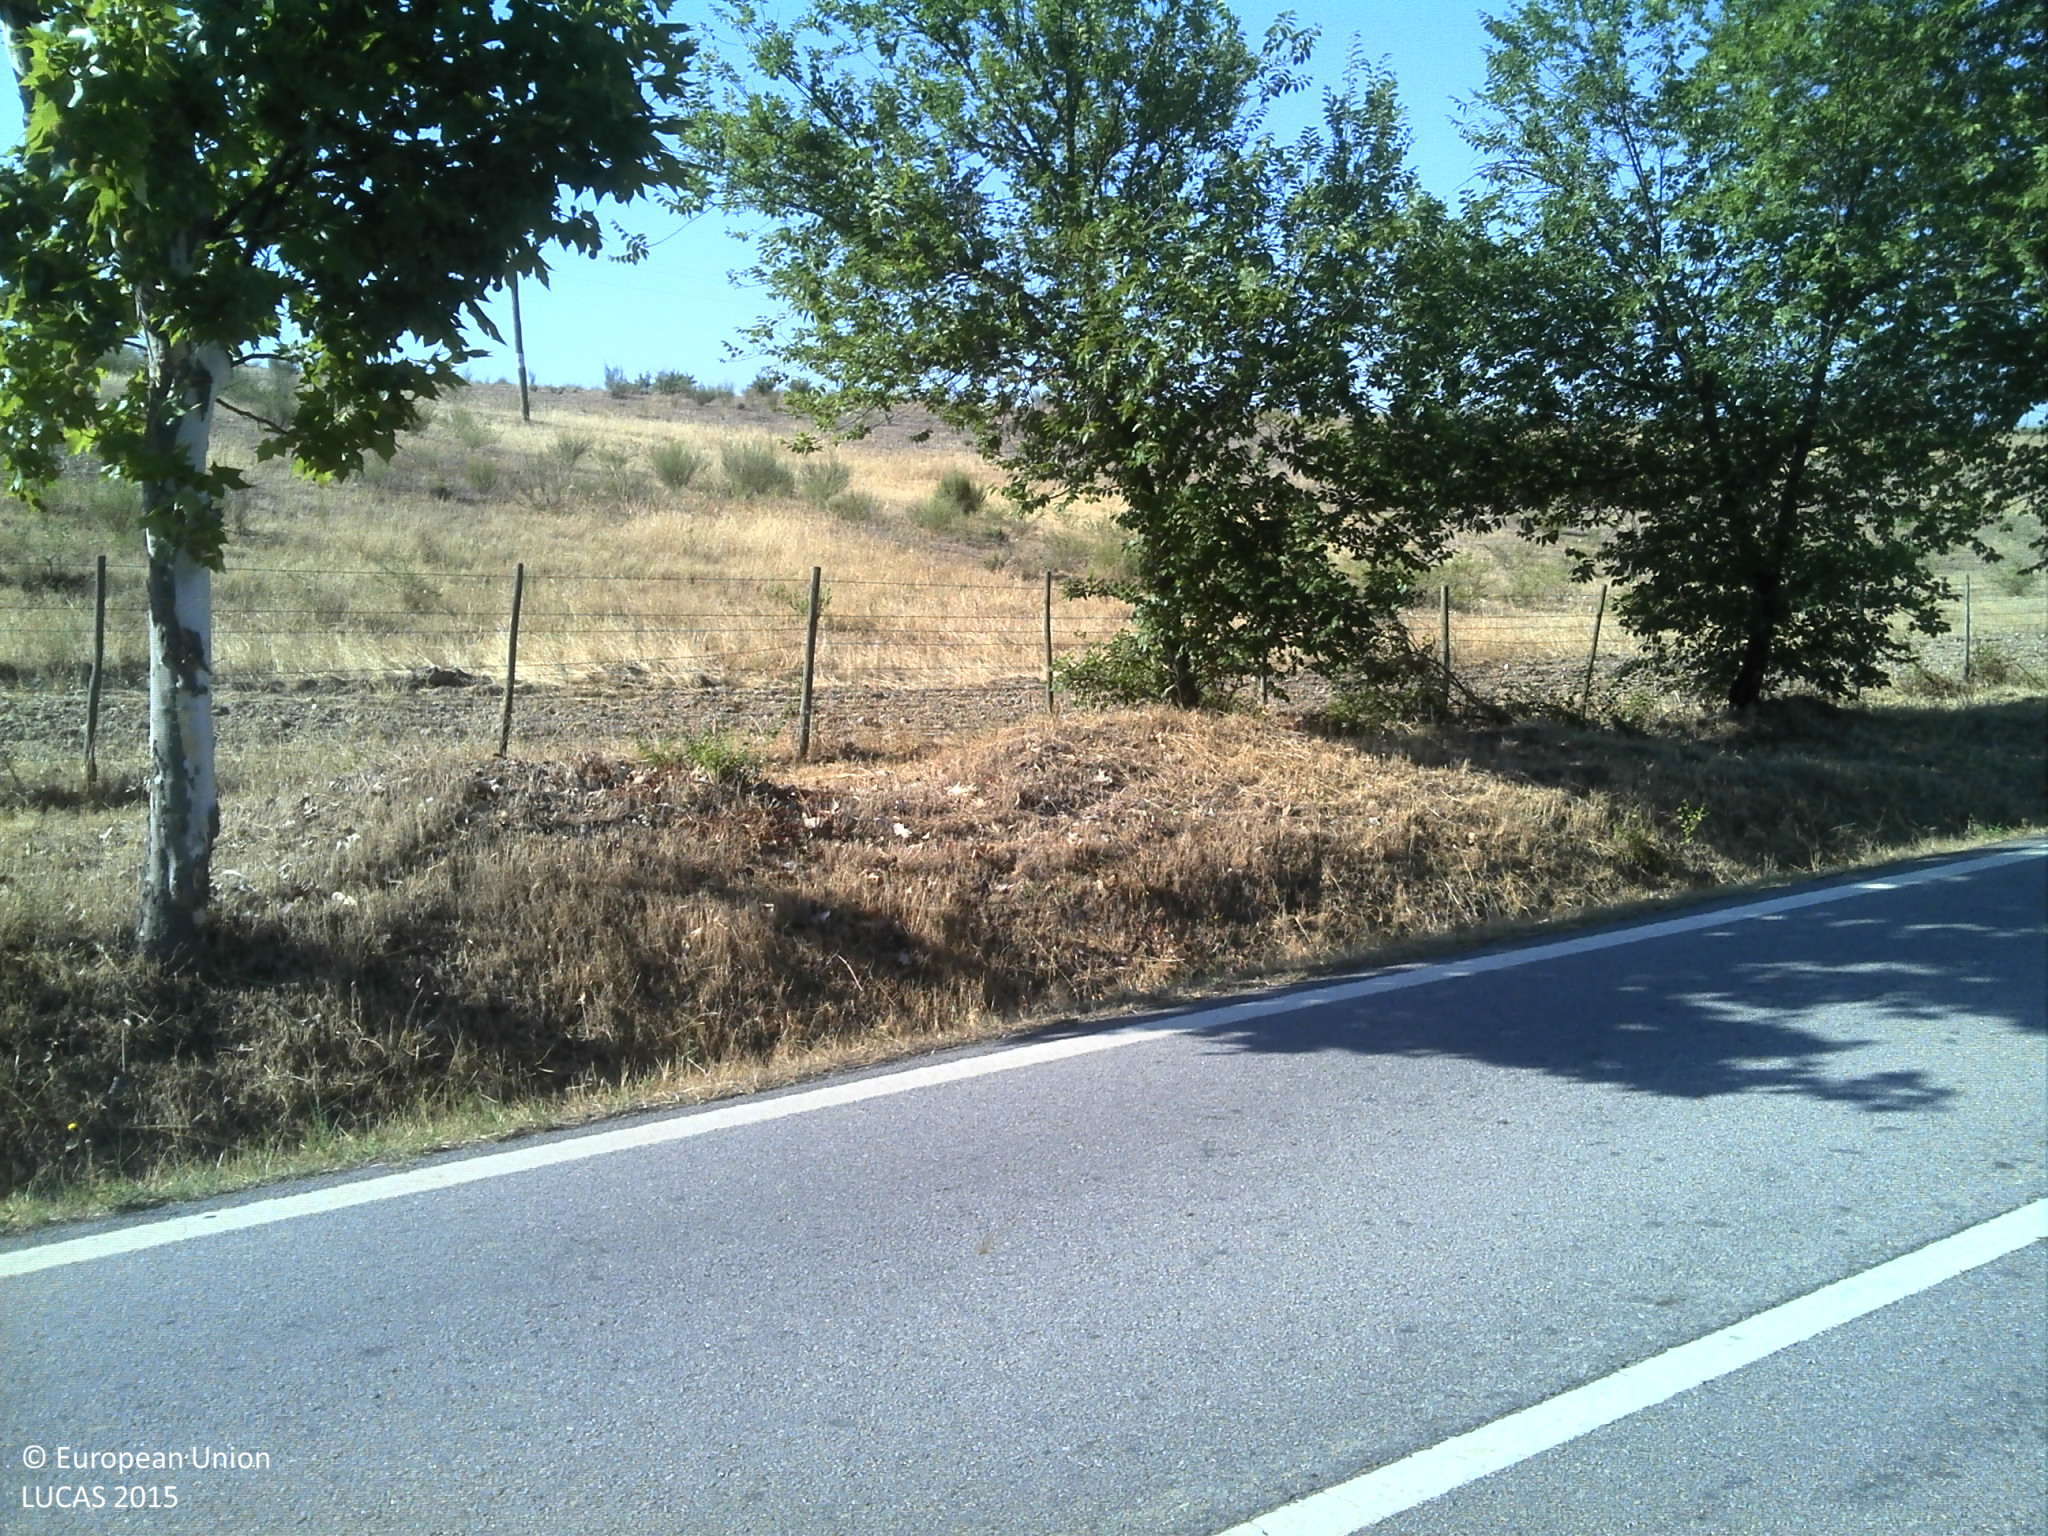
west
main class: Grassland
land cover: Grassland with sparse tree/shrub cover
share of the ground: 50 - 75 %
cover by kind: herbaceous plants 55 %, unconsolidated bare surface 30 %, broadleaved forest trees 5 %, shrubs 5 %
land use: Agriculture (excluding fallow land and kitchen gardens)
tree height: > 5 m
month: June
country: PT
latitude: 39.9104
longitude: -7.2319
